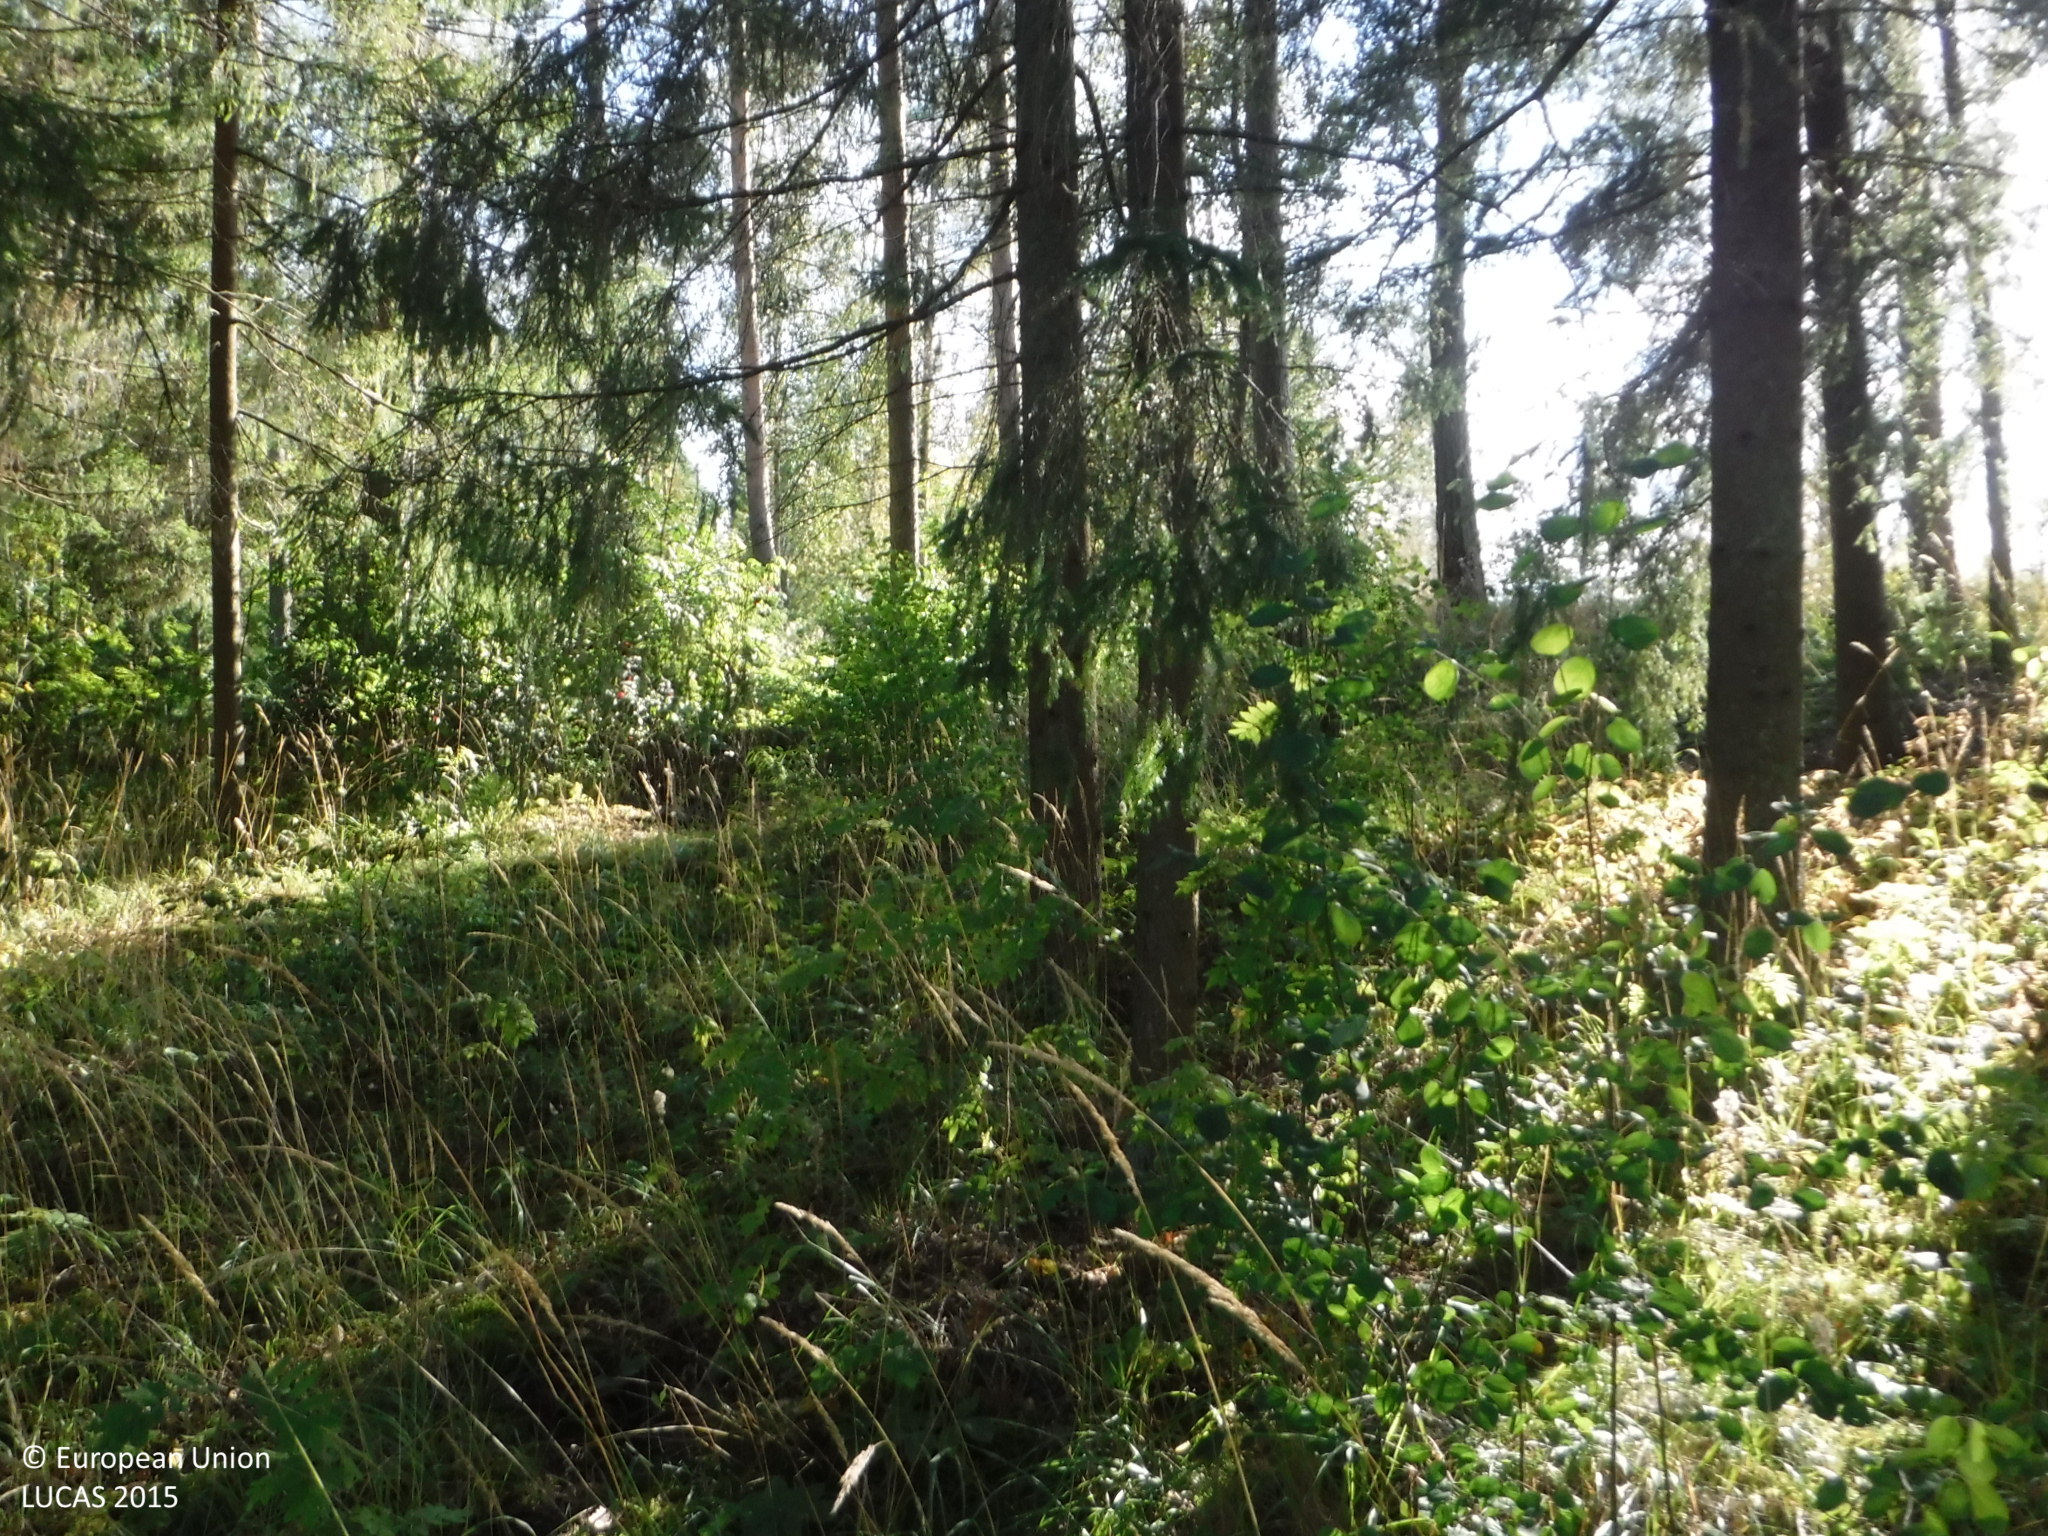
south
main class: Woodland
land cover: Spruce dominated coniferous woodland
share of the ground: > 75 %
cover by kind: coniferous forest trees 75 %, herbaceous plants 15 %, broadleaved forest trees 5 %, lichens and mosses 5 %
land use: Forestry
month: September
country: FI
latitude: 61.3977
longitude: 22.6688
